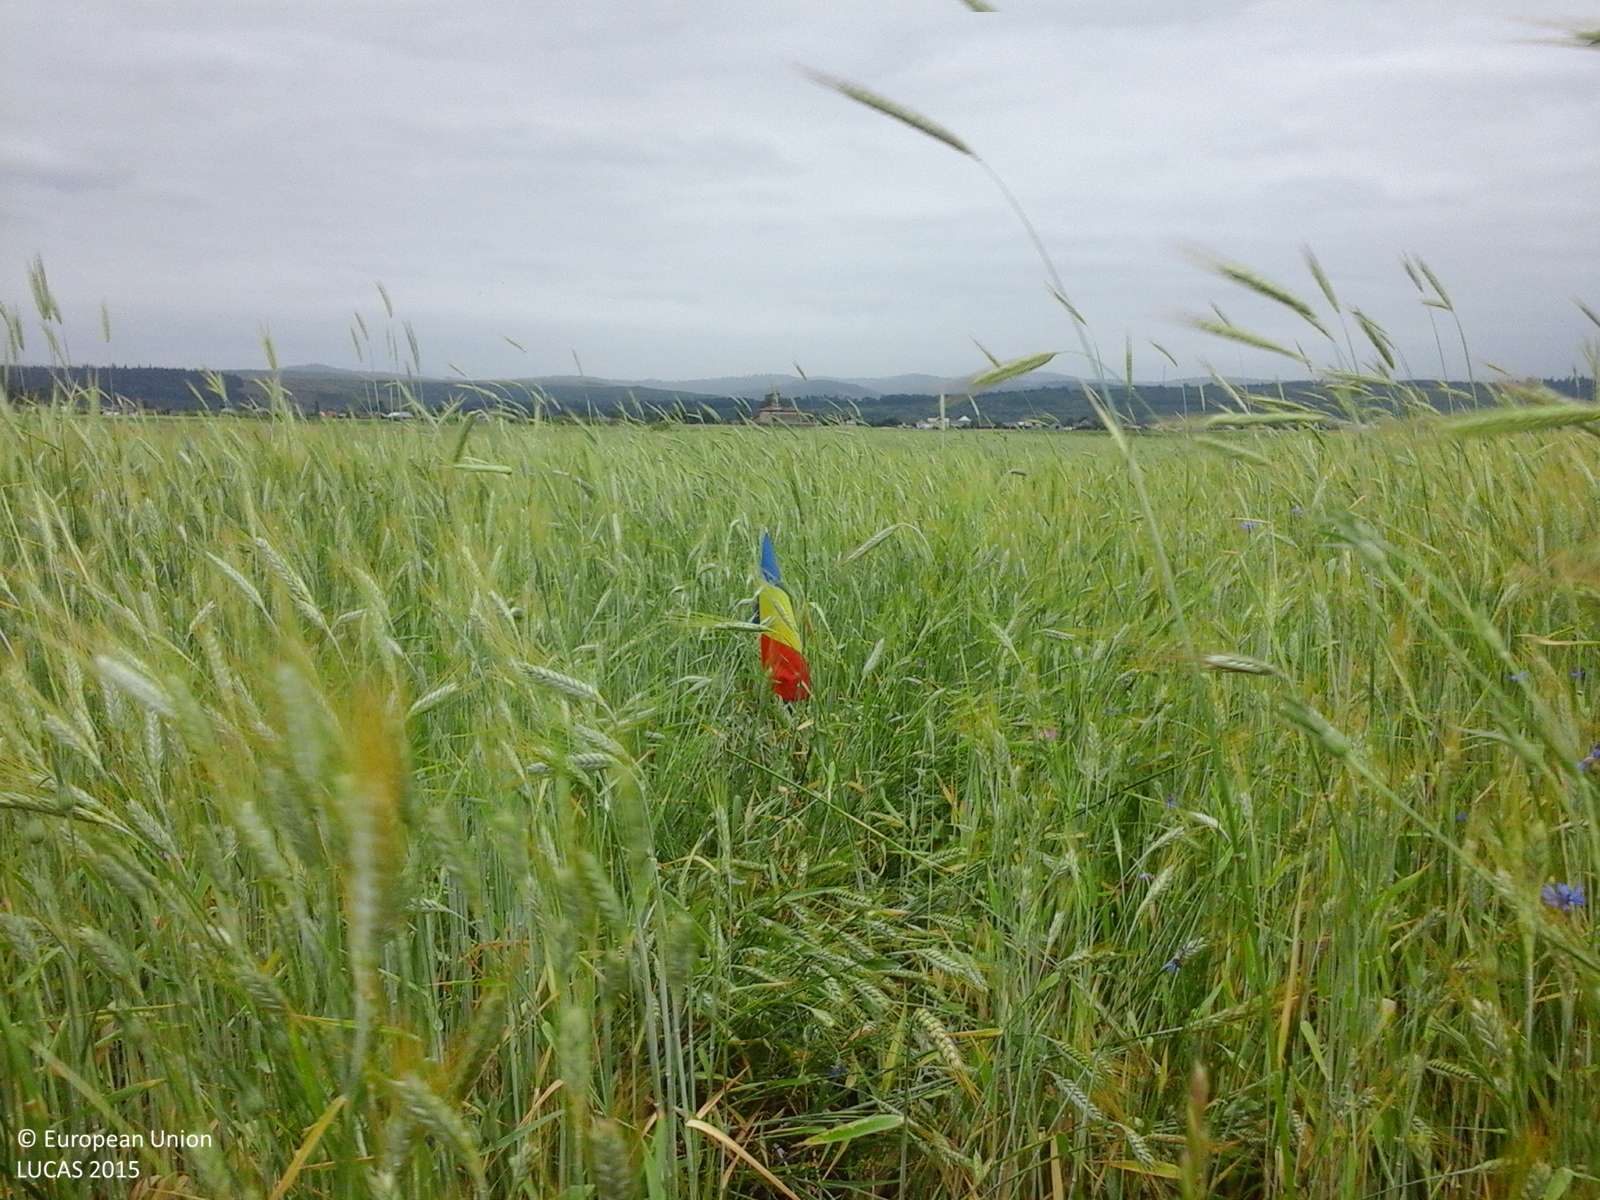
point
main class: Cropland
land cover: Common wheat
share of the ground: > 75 %
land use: Agriculture (excluding fallow land and kitchen gardens)
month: June
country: RO
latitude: 47.4343
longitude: 26.2167
